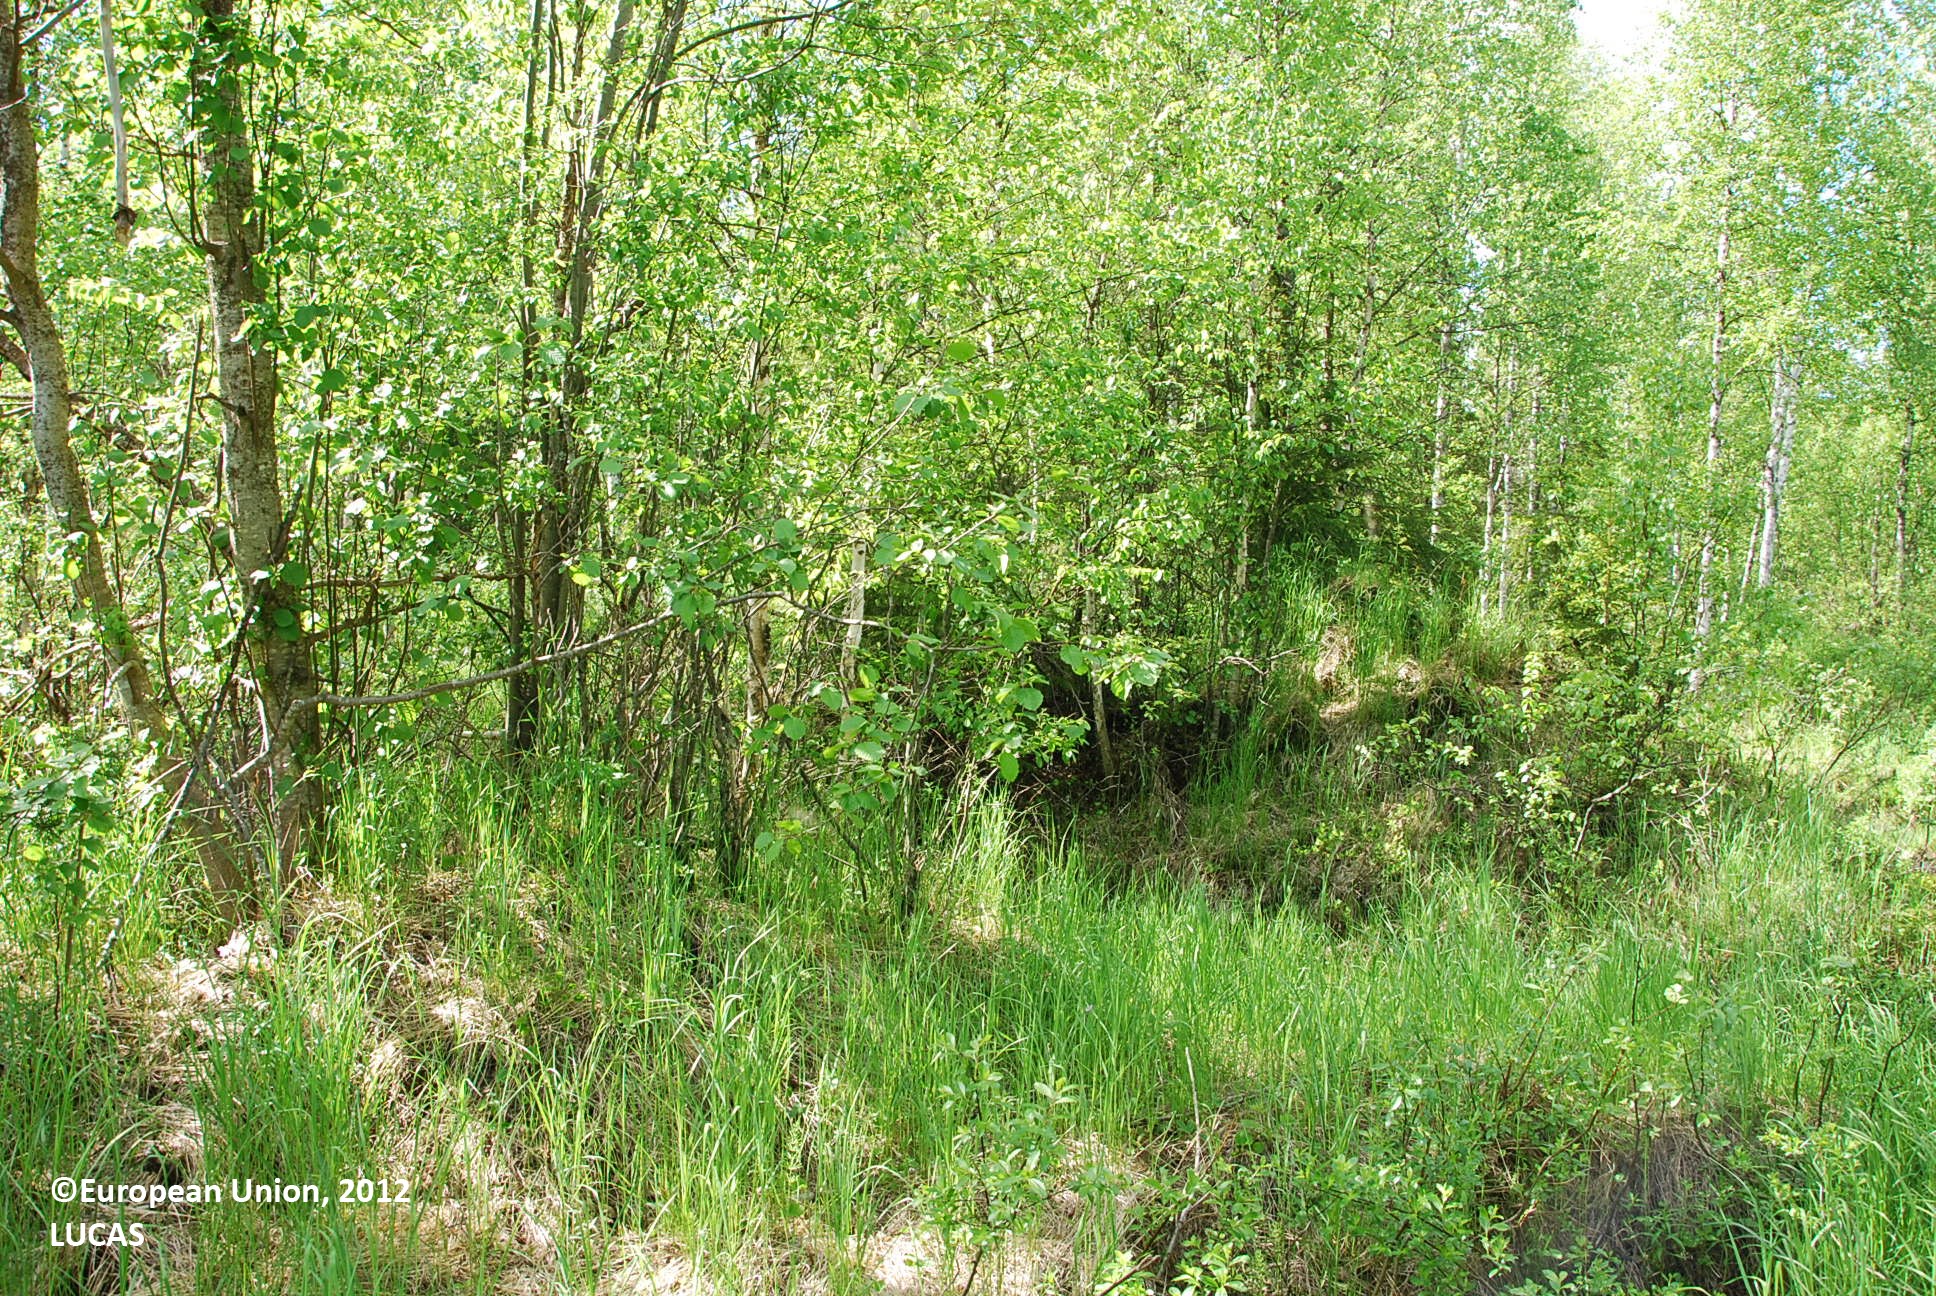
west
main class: Woodland
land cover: Broadleaved woodland
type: boreal forest
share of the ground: > 75 %
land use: Forestry
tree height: > 5 m
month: June
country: FI
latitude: 66.3735
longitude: 27.1679
